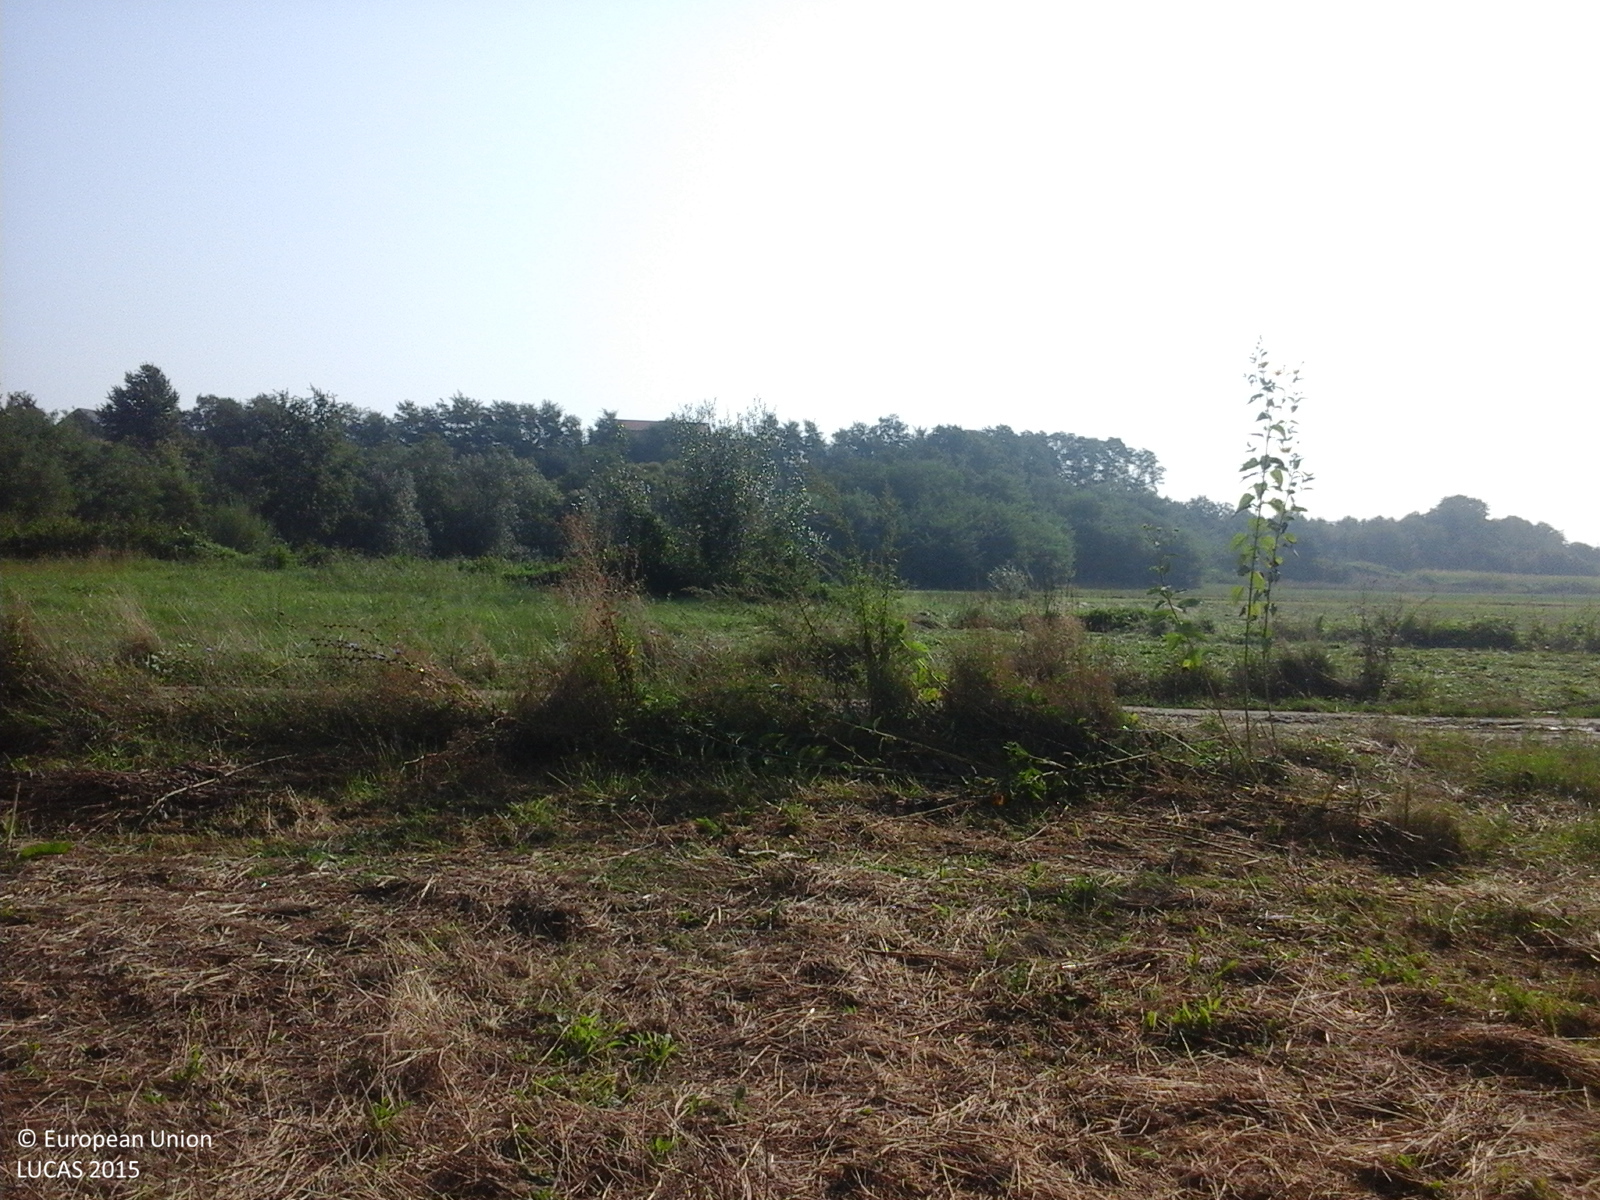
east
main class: Grassland
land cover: Grassland without tree/shrub cover
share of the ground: > 75 %
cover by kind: herbaceous plants 100 %
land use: Agriculture (excluding fallow land and kitchen gardens)
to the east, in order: Grassland without tree/shrub cover; Tracks; Grassland without tree/shrub cover; Single bushes/trees; Grassland without tree/shrub cover; Broadleaved woodland; Grassland without tree/shrub cover; Broadleaved woodland; Artificial constructions in urban areas
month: September
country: RO
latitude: 47.1789
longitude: 24.1368
